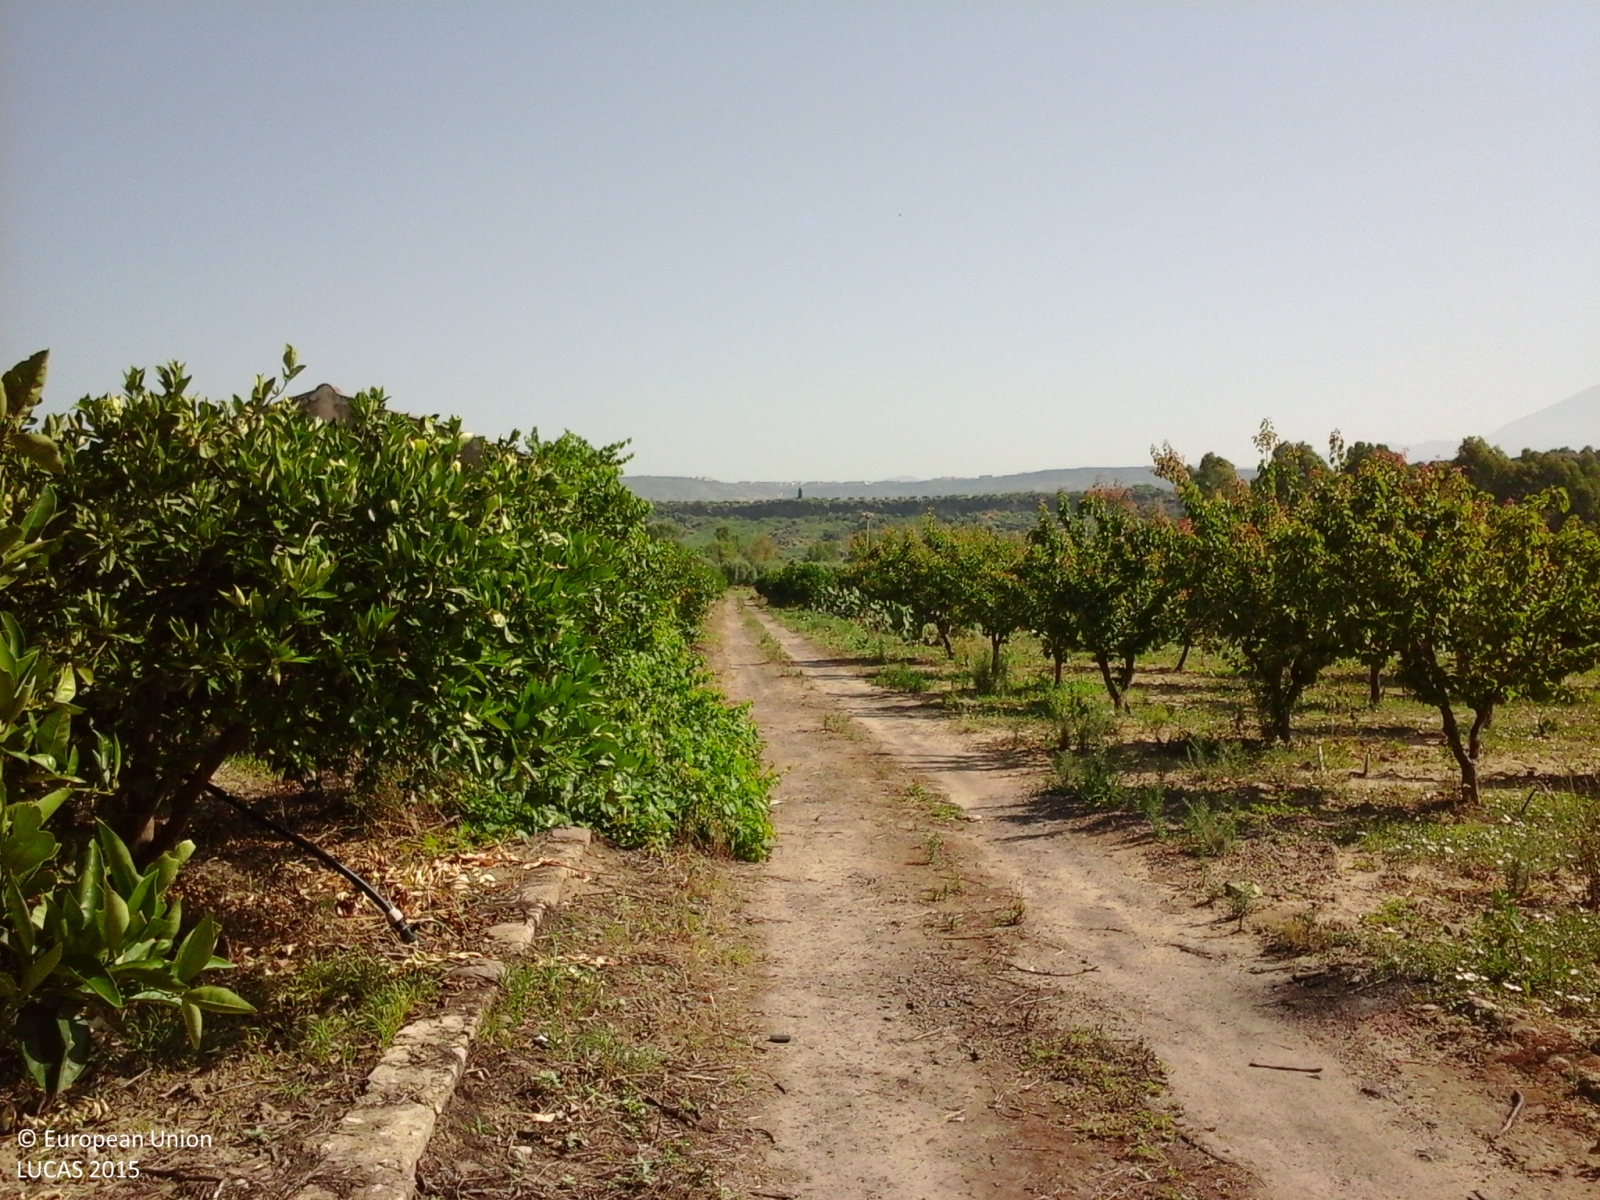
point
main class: Cropland
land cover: Oranges
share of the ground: > 75 %
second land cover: Spontaneously vegetated surfaces
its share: > 75 %
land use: Agriculture (excluding fallow land and kitchen gardens)
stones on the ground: 10 - 25 %
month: June
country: IT
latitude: 37.6069
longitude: 14.8251
